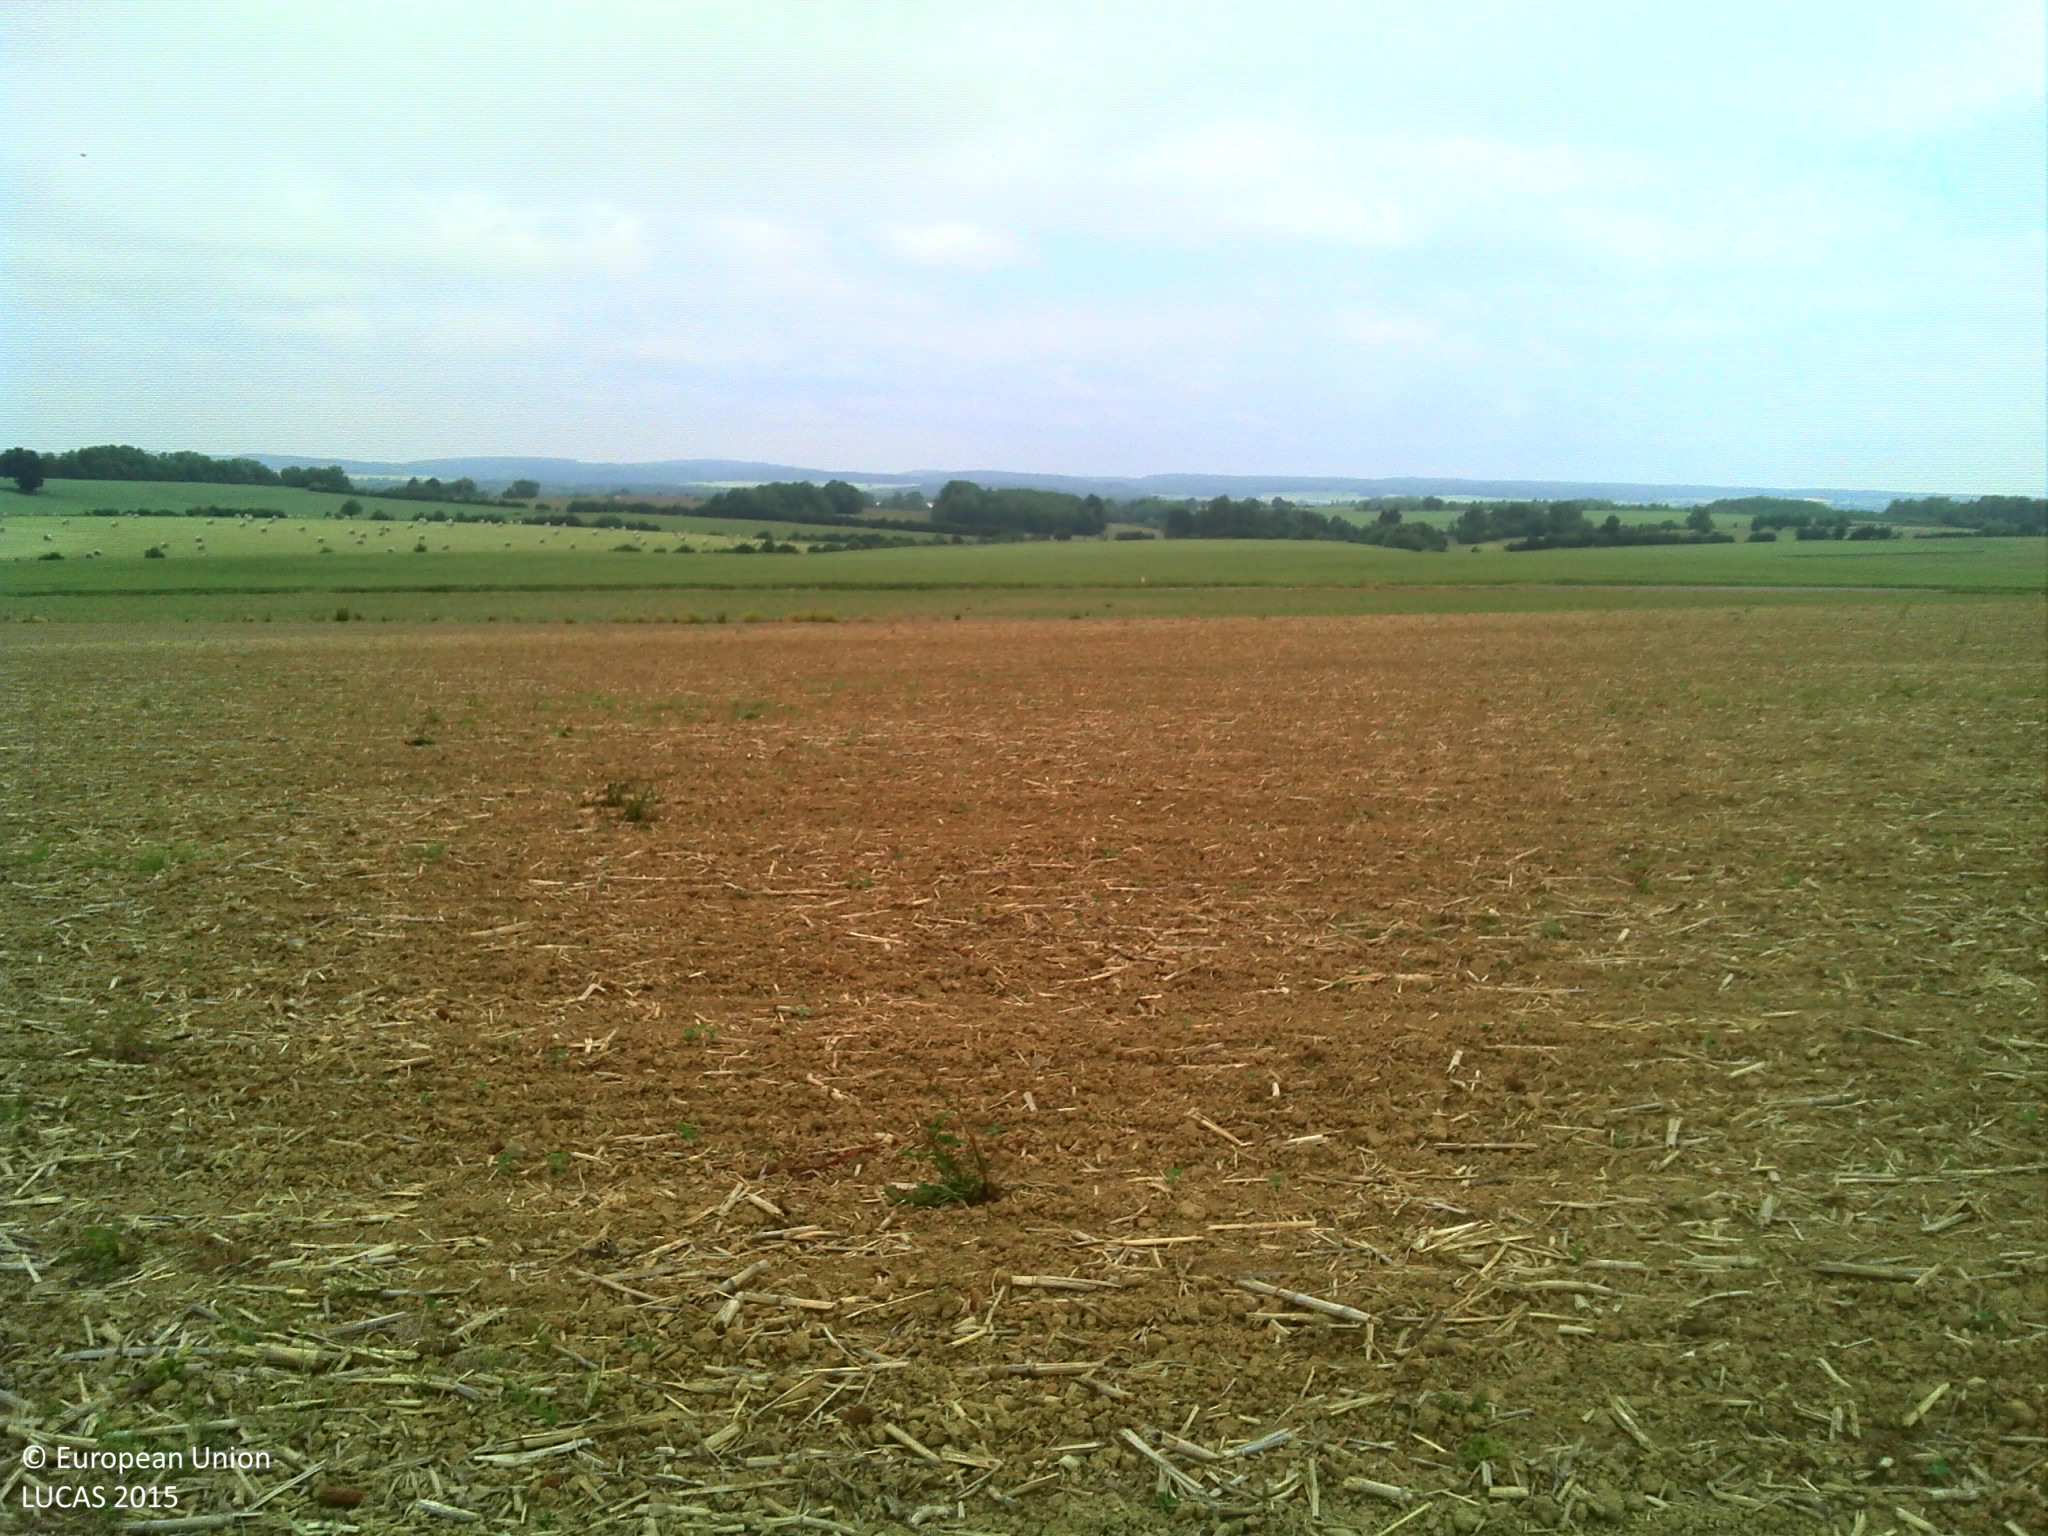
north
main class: Cropland
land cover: Soya
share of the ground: < 10 %
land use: Agriculture (excluding fallow land and kitchen gardens)
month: June
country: FR
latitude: 47.7598
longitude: 6.1455
